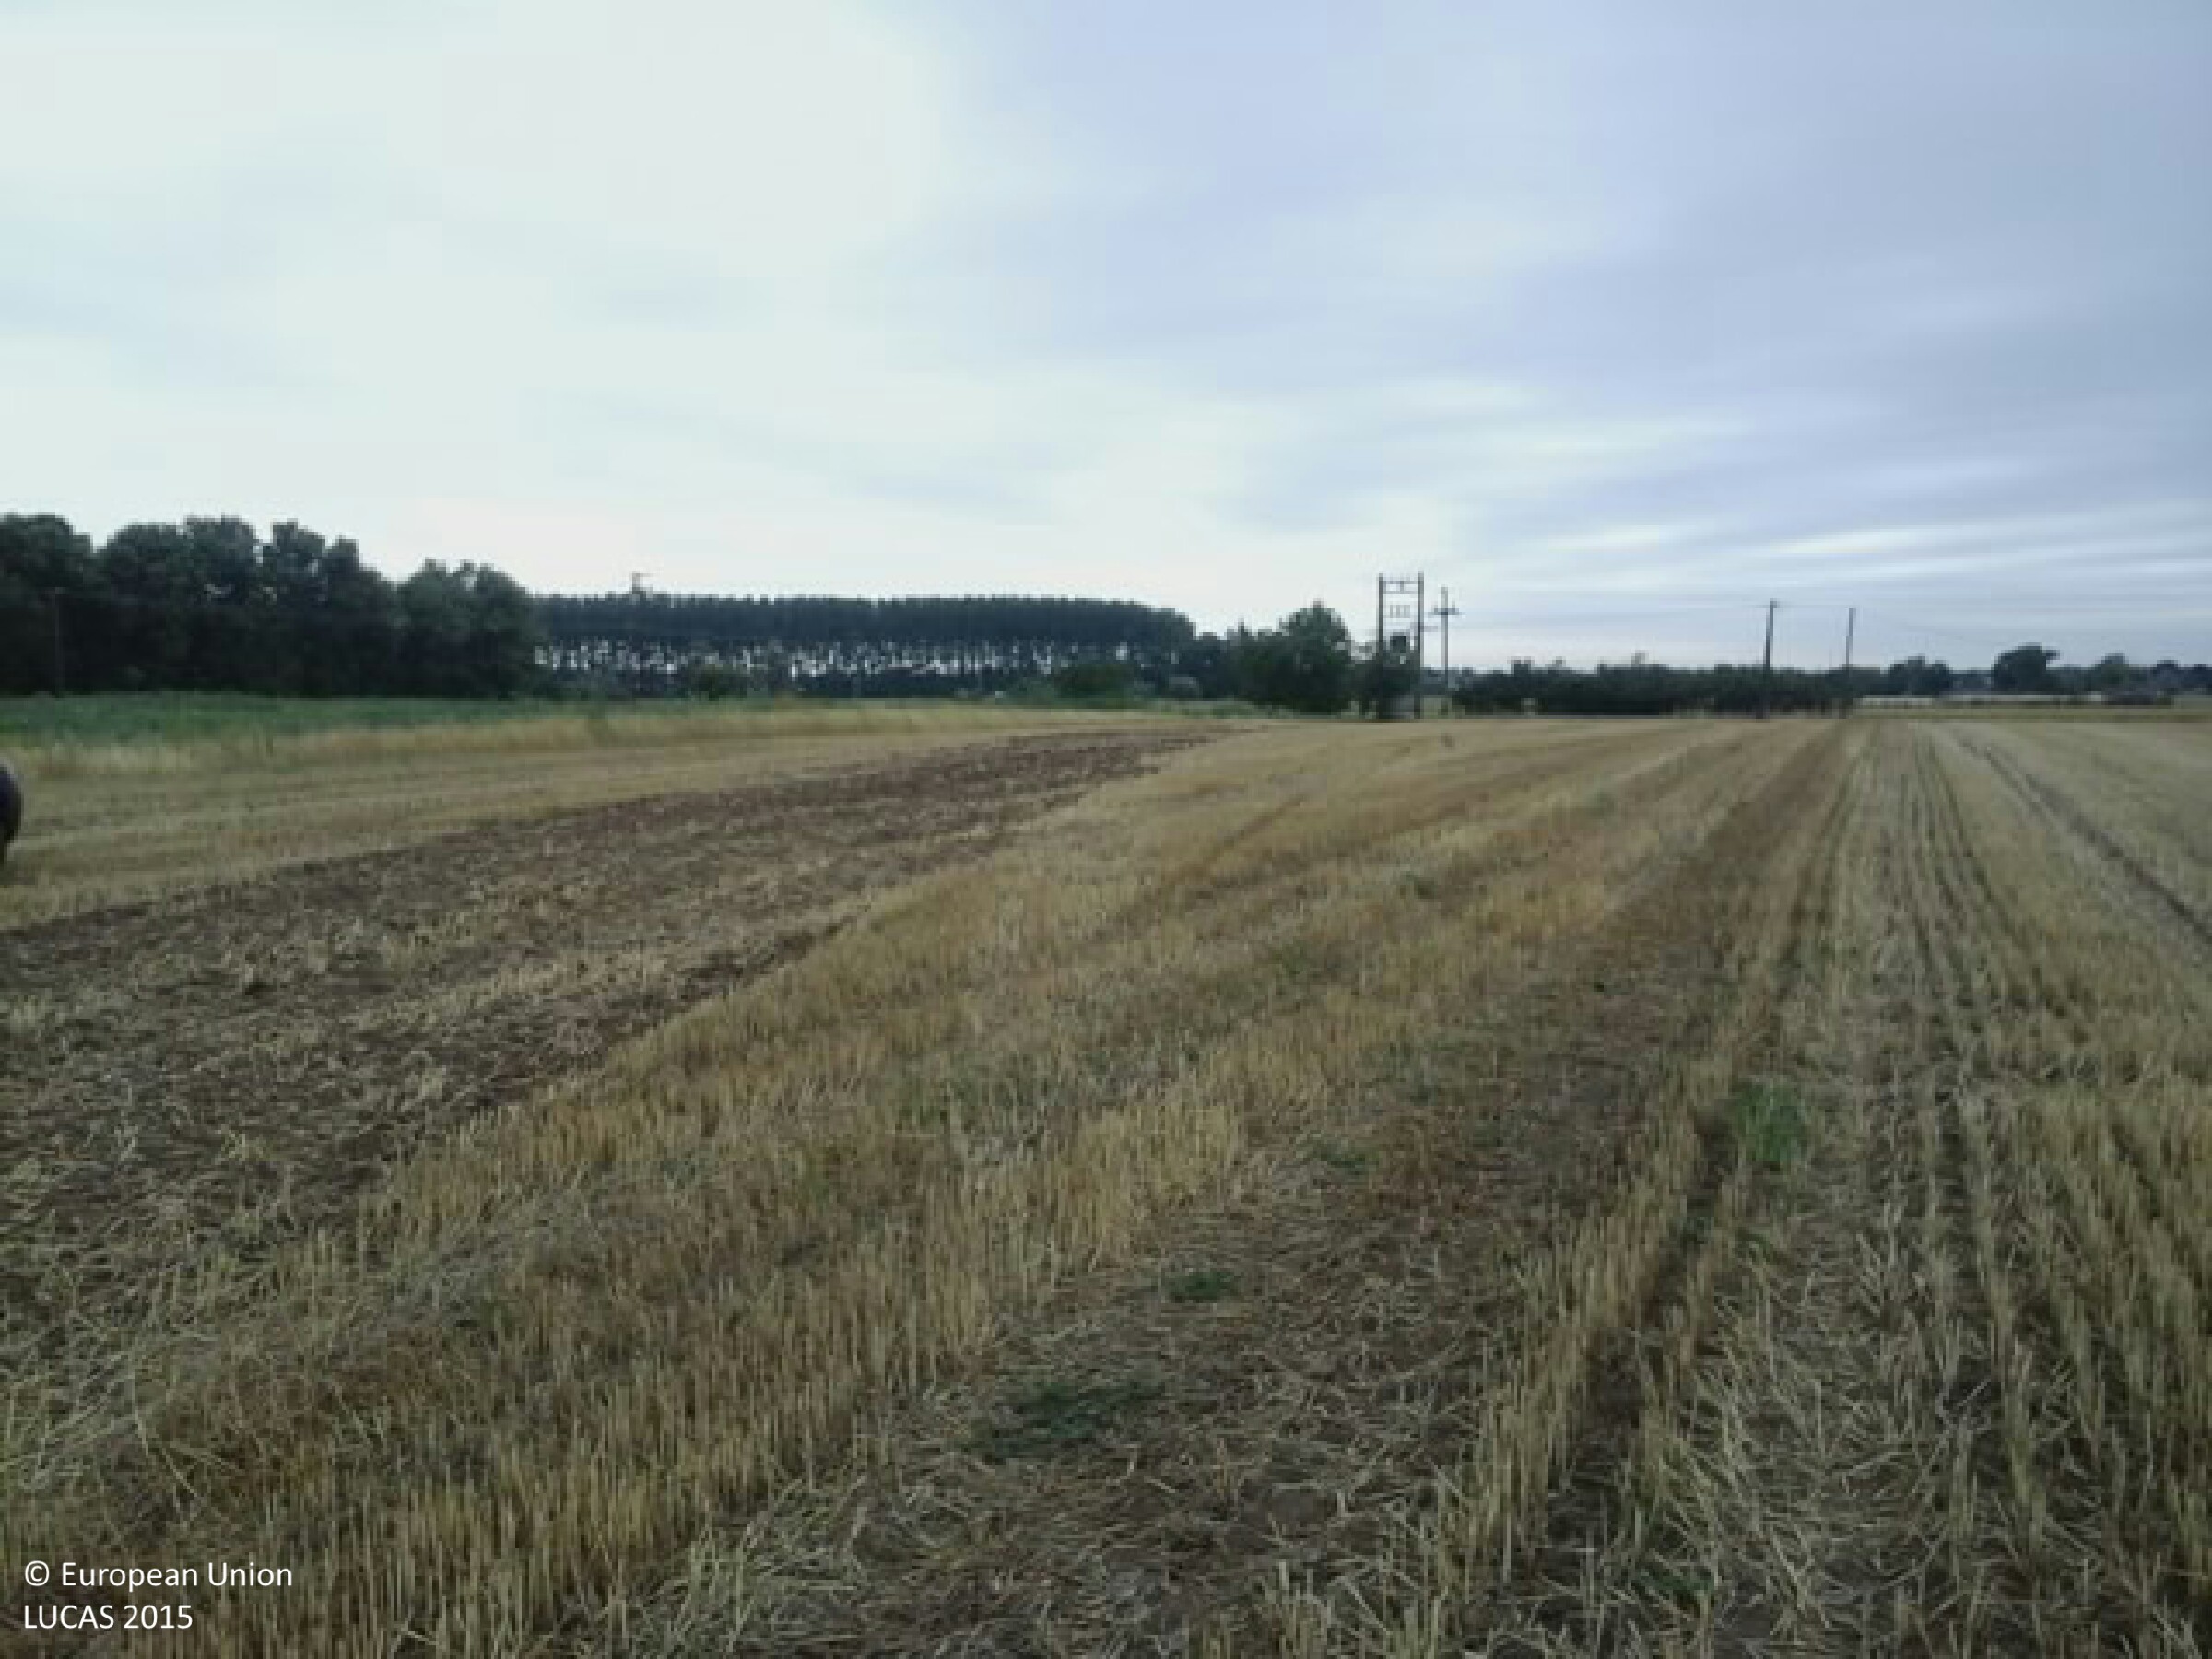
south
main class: Cropland
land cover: Common wheat
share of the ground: 10 - 25 %
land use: Agriculture (excluding fallow land and kitchen gardens)
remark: Harvested field
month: July
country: HU
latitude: 47.0425
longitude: 19.8013
